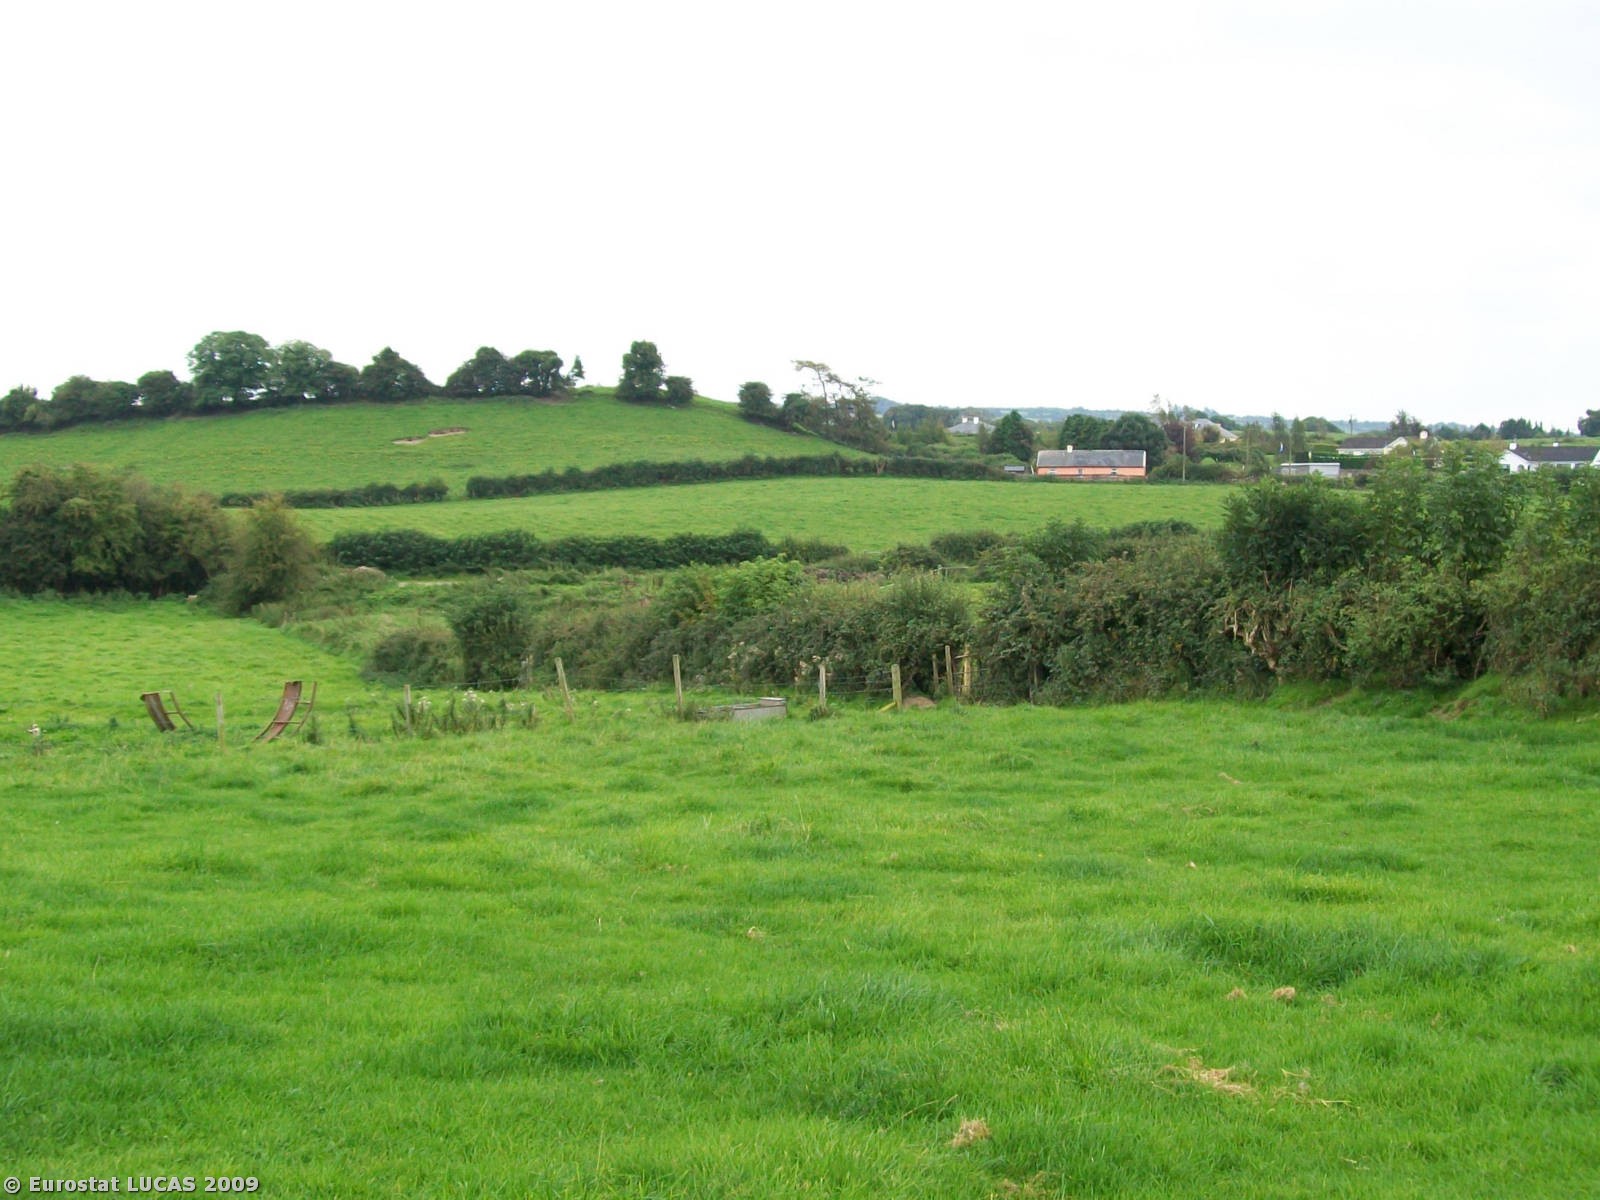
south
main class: Grassland
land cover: Grassland without tree/shrub cover
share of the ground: > 75 %
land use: Agriculture (excluding fallow land and kitchen gardens)
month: September
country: IE
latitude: 52.9687
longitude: -7.8137
